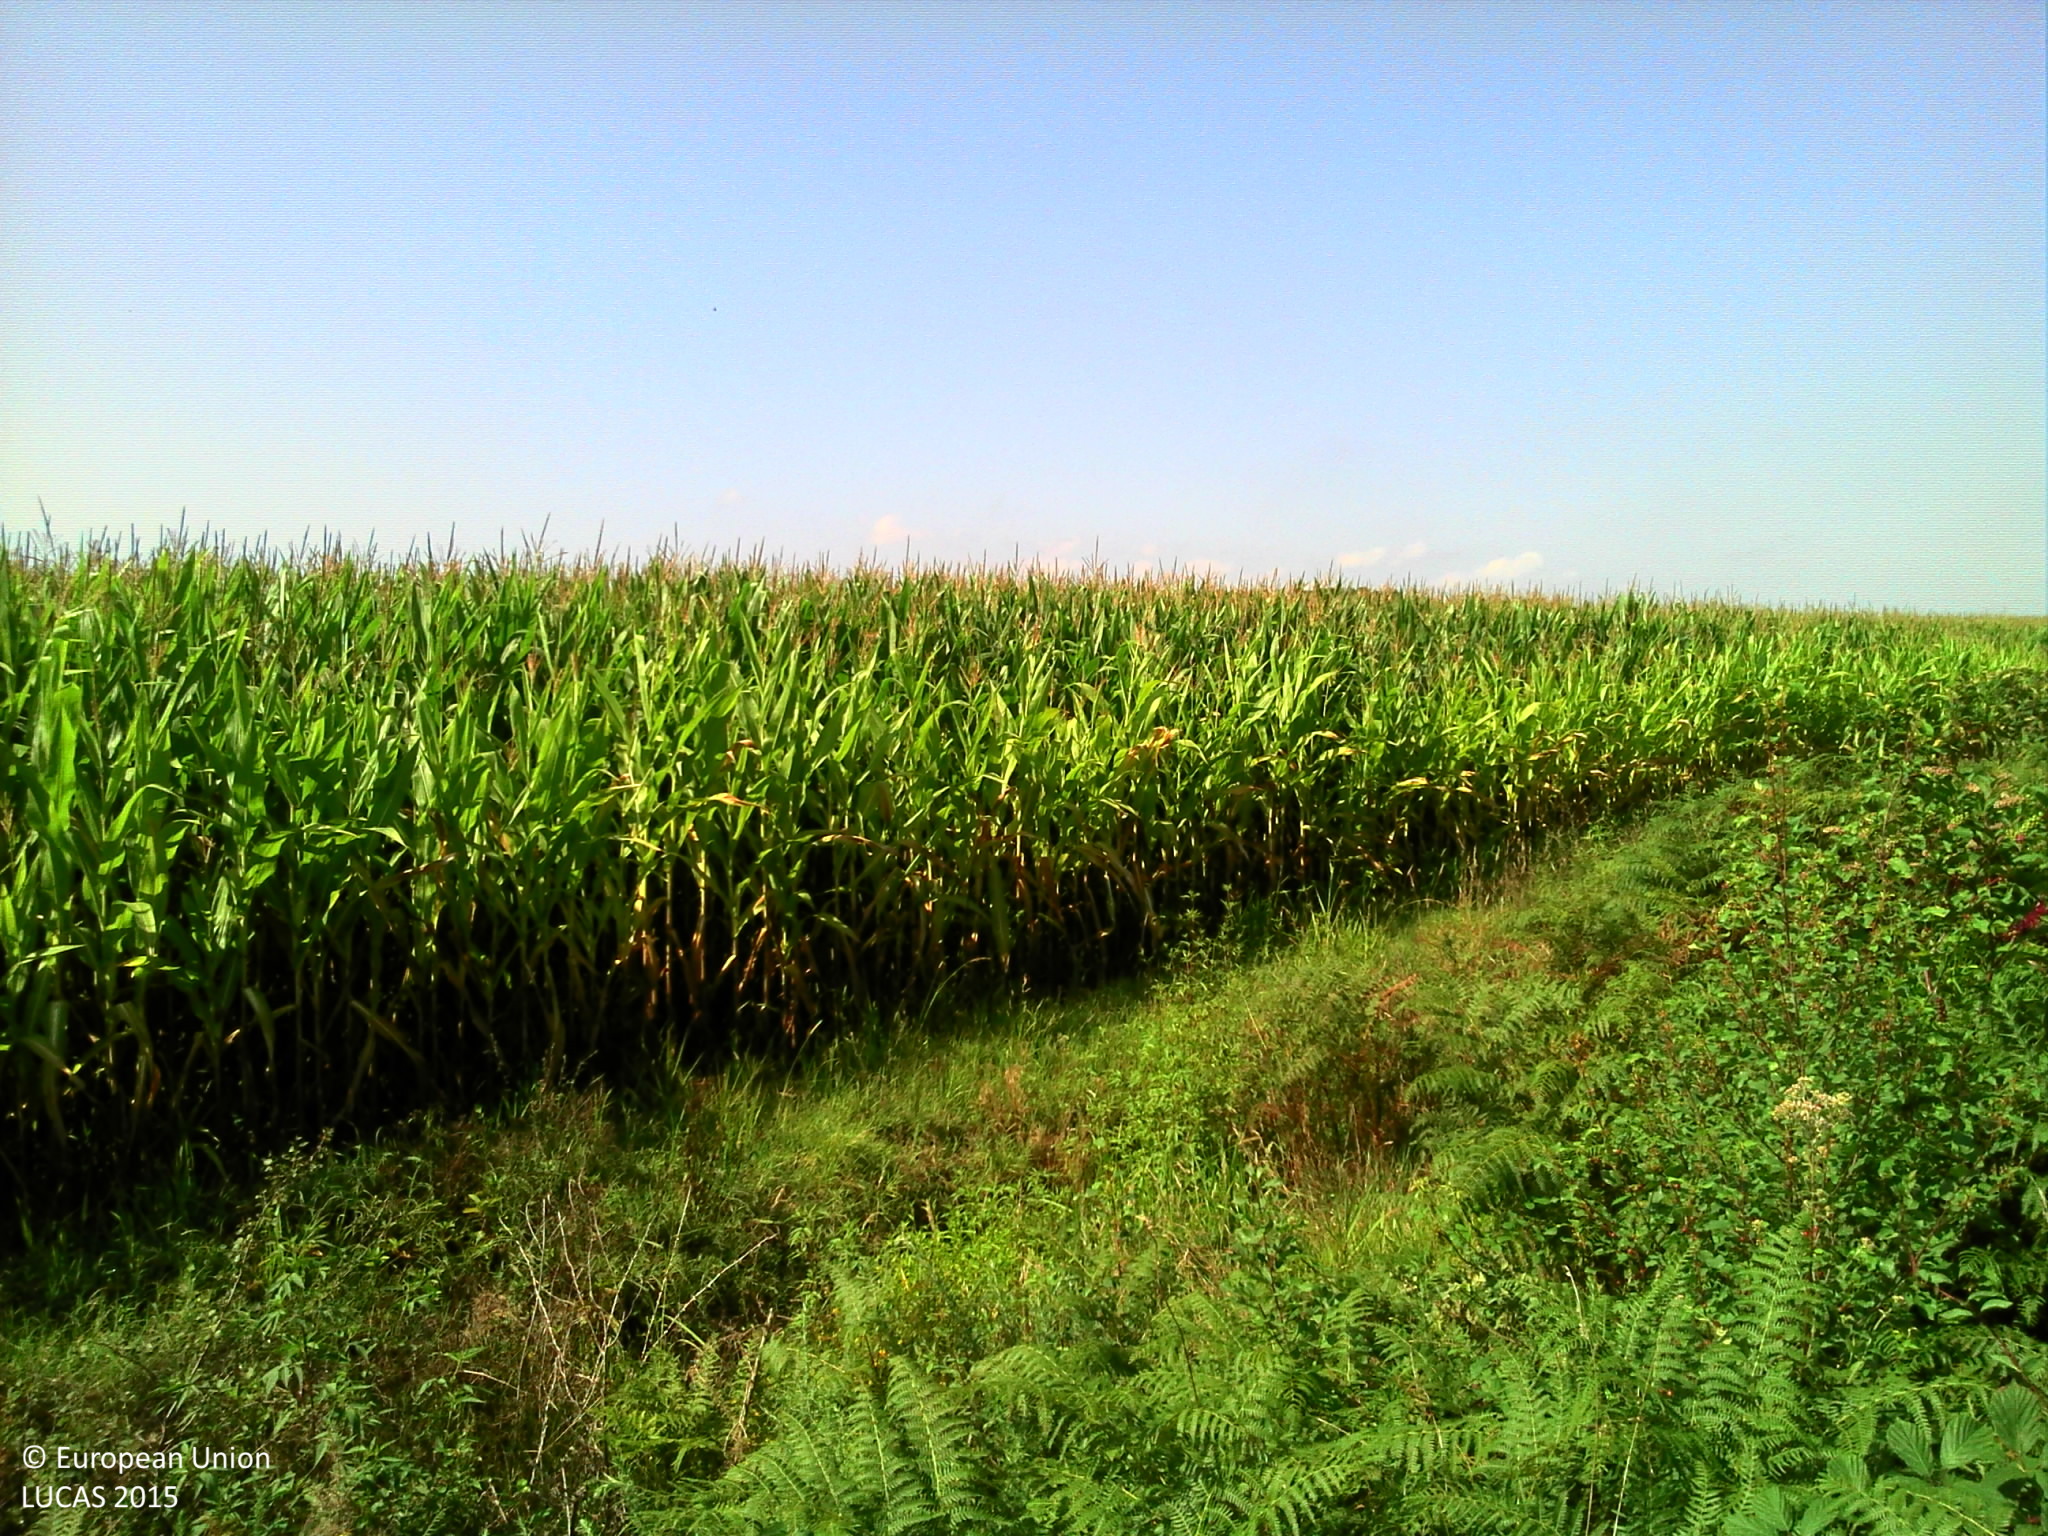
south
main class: Cropland
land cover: Maize
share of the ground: > 75 %
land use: Agriculture (excluding fallow land and kitchen gardens)
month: August
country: FR
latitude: 43.7918
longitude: -0.5627
